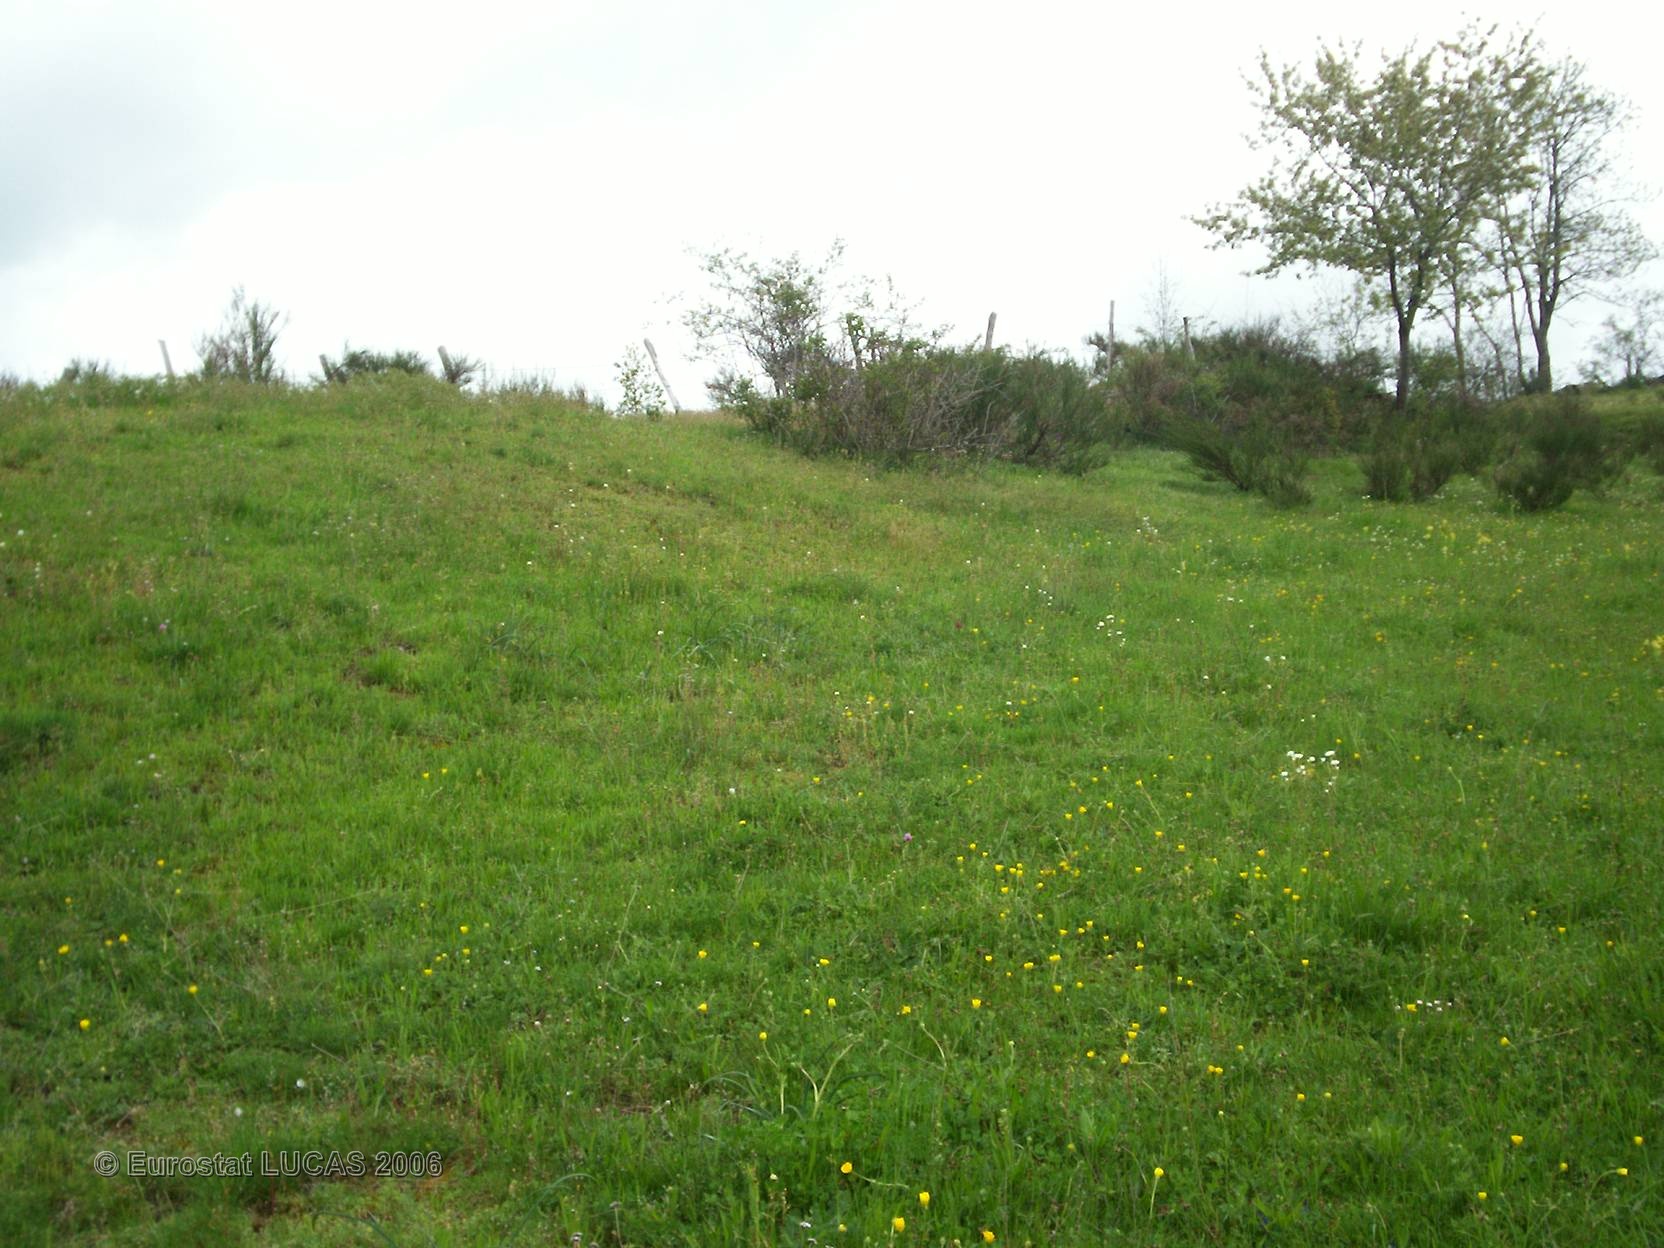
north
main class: Grassland
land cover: Grassland without tree/shrub cover
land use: Agriculture (excluding fallow land and kitchen gardens)
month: May
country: FR
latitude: 45.2154
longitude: 3.2405
